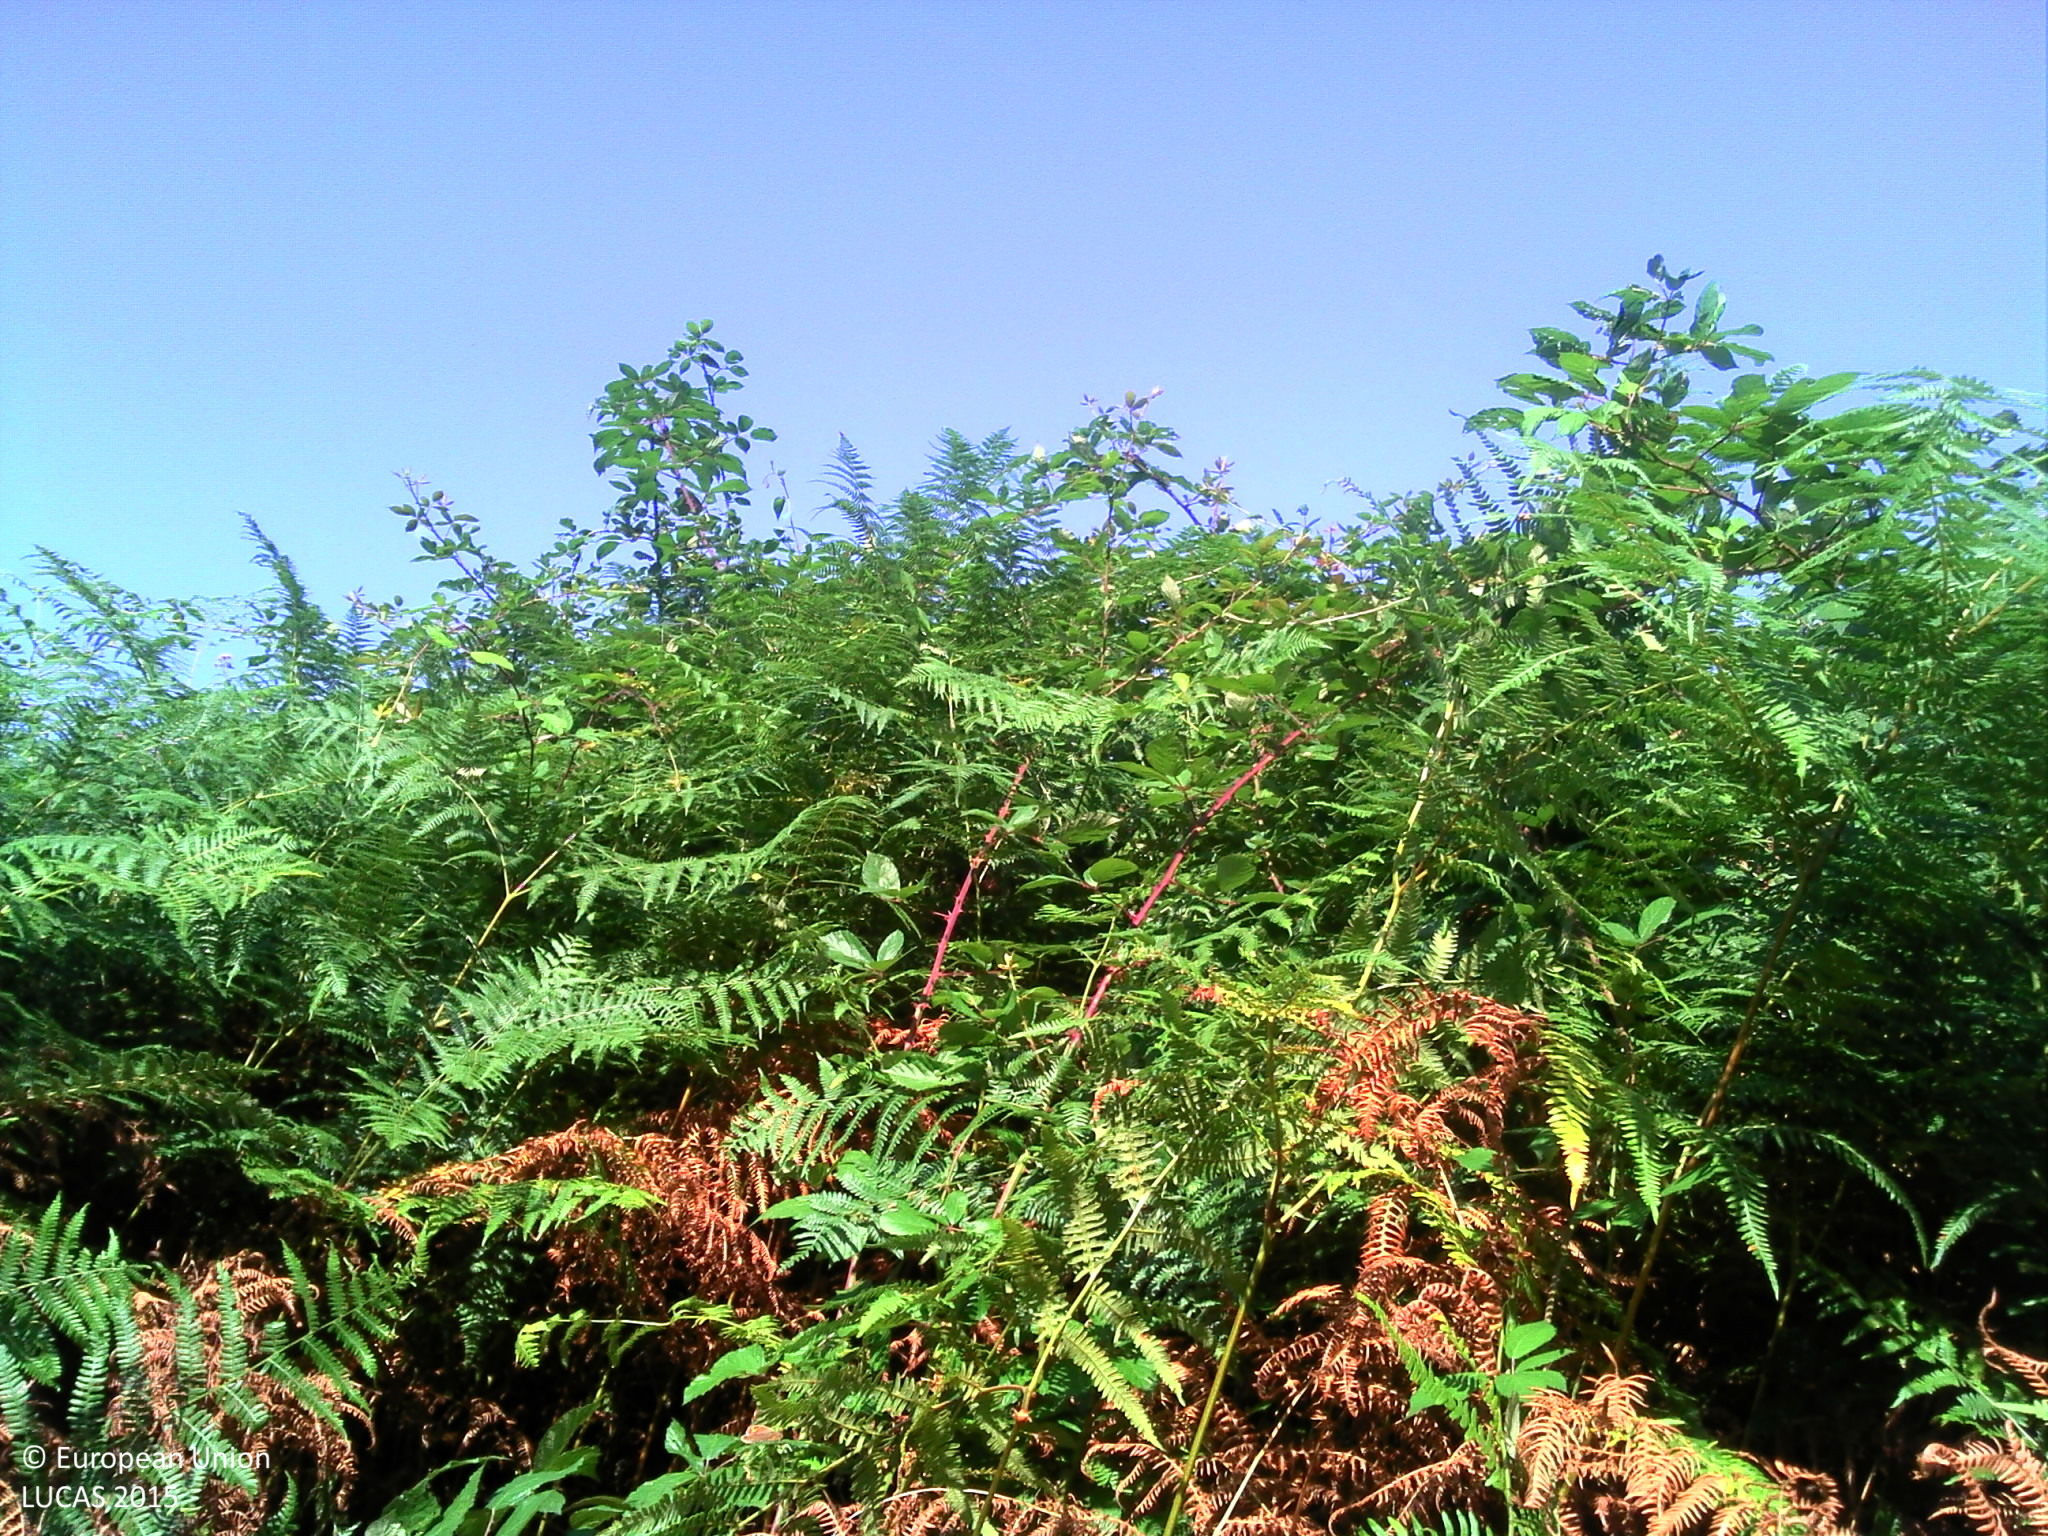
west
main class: Grassland
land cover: Spontaneously vegetated surfaces
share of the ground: > 75 %
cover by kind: herbaceous plants 95 %, shrubs 5 %
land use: Forestry
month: August
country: FR
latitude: 43.4717
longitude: -1.1778
